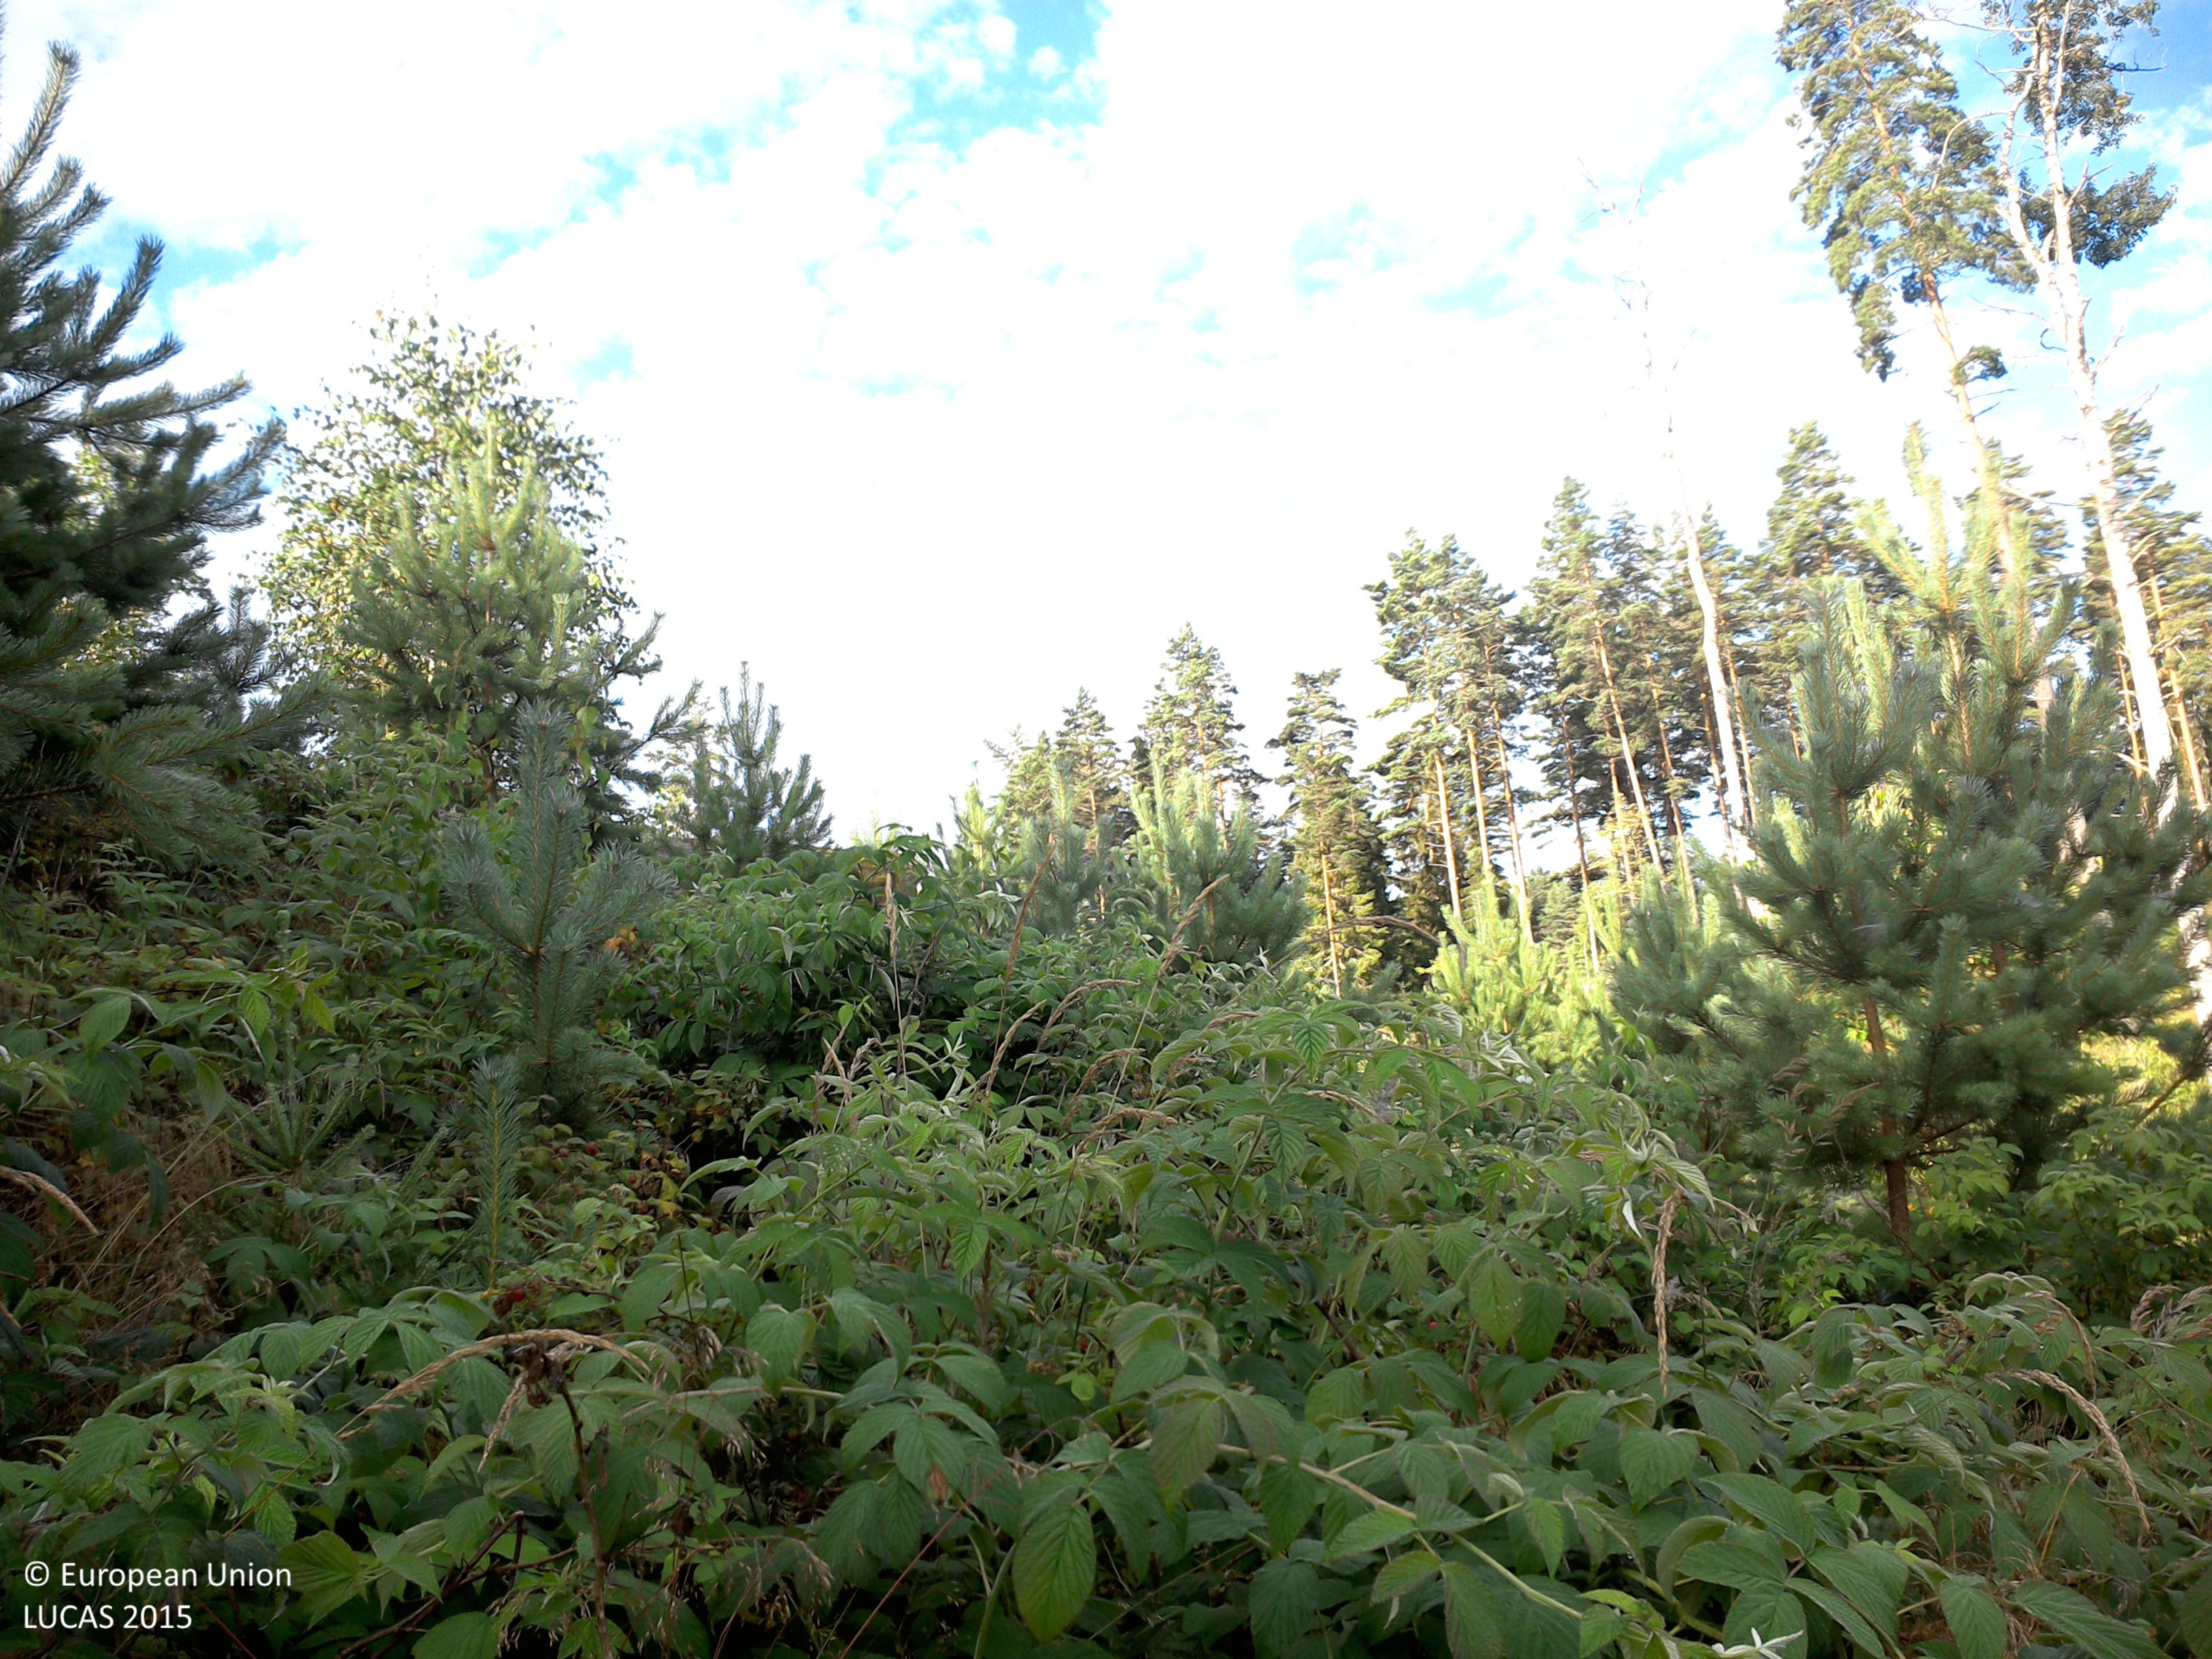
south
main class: Shrubland
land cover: Shrubland with sparse tree cover
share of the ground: > 75 %
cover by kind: shrubs 80 %, herbaceous plants 15 %, coniferous forest trees 5 %
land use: Forestry
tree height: < 5 m
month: August
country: SE
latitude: 58.1252
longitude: 15.0373
